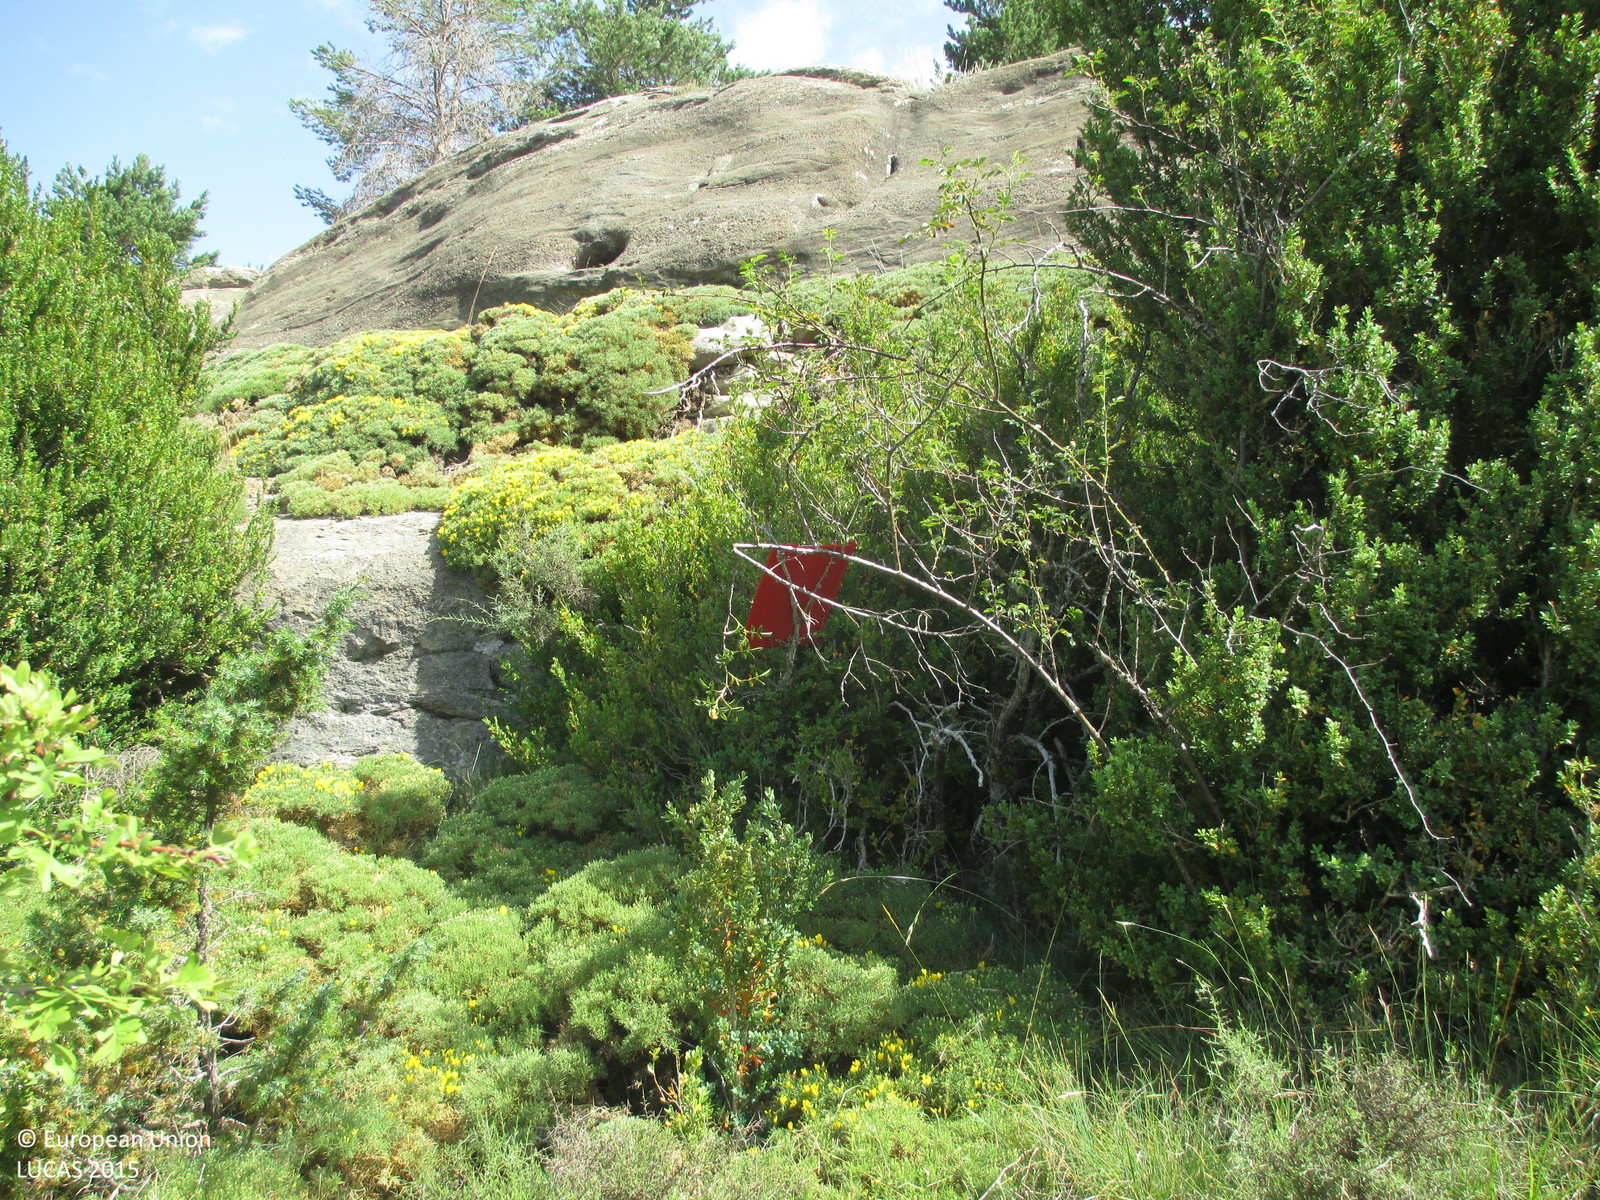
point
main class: Shrubland
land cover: Shrubland with sparse tree cover
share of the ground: > 75 %
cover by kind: shrubs 85 %, coniferous forest trees 5 %, herbaceous plants 5 %, consolidated bare surface 5 %
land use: Semi-natural and natural areas not in use
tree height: > 5 m
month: July
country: ES
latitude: 42.3558
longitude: -0.3801
